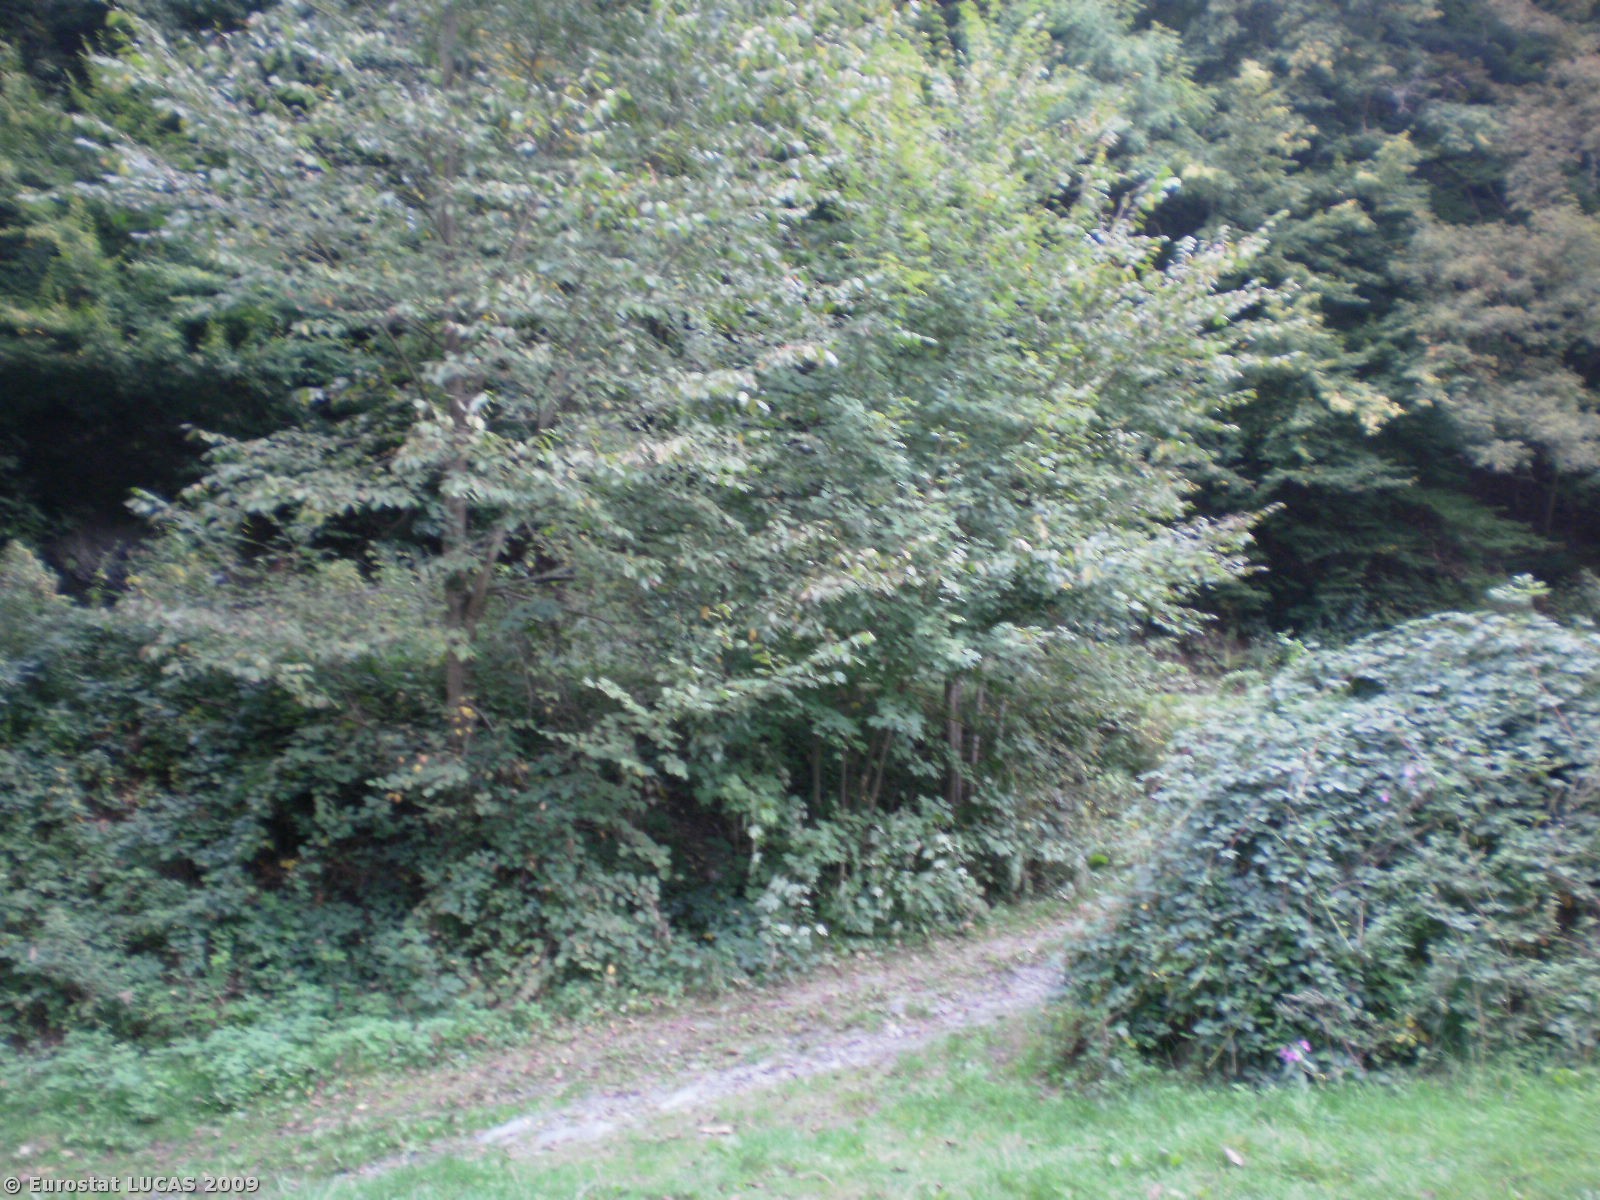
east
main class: Woodland
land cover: Broadleaved woodland
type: mountainous beech forest
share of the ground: > 75 %
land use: Forestry
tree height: > 5 m
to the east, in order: Broadleaved woodland; Grassland without tree/shrub cover; Inland running water; Grassland without tree/shrub cover; Tracks; Broadleaved woodland; Paved roads, cycling and walking lanes; Broadleaved woodland
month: September
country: BE
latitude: 50.1720
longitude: 5.6161
